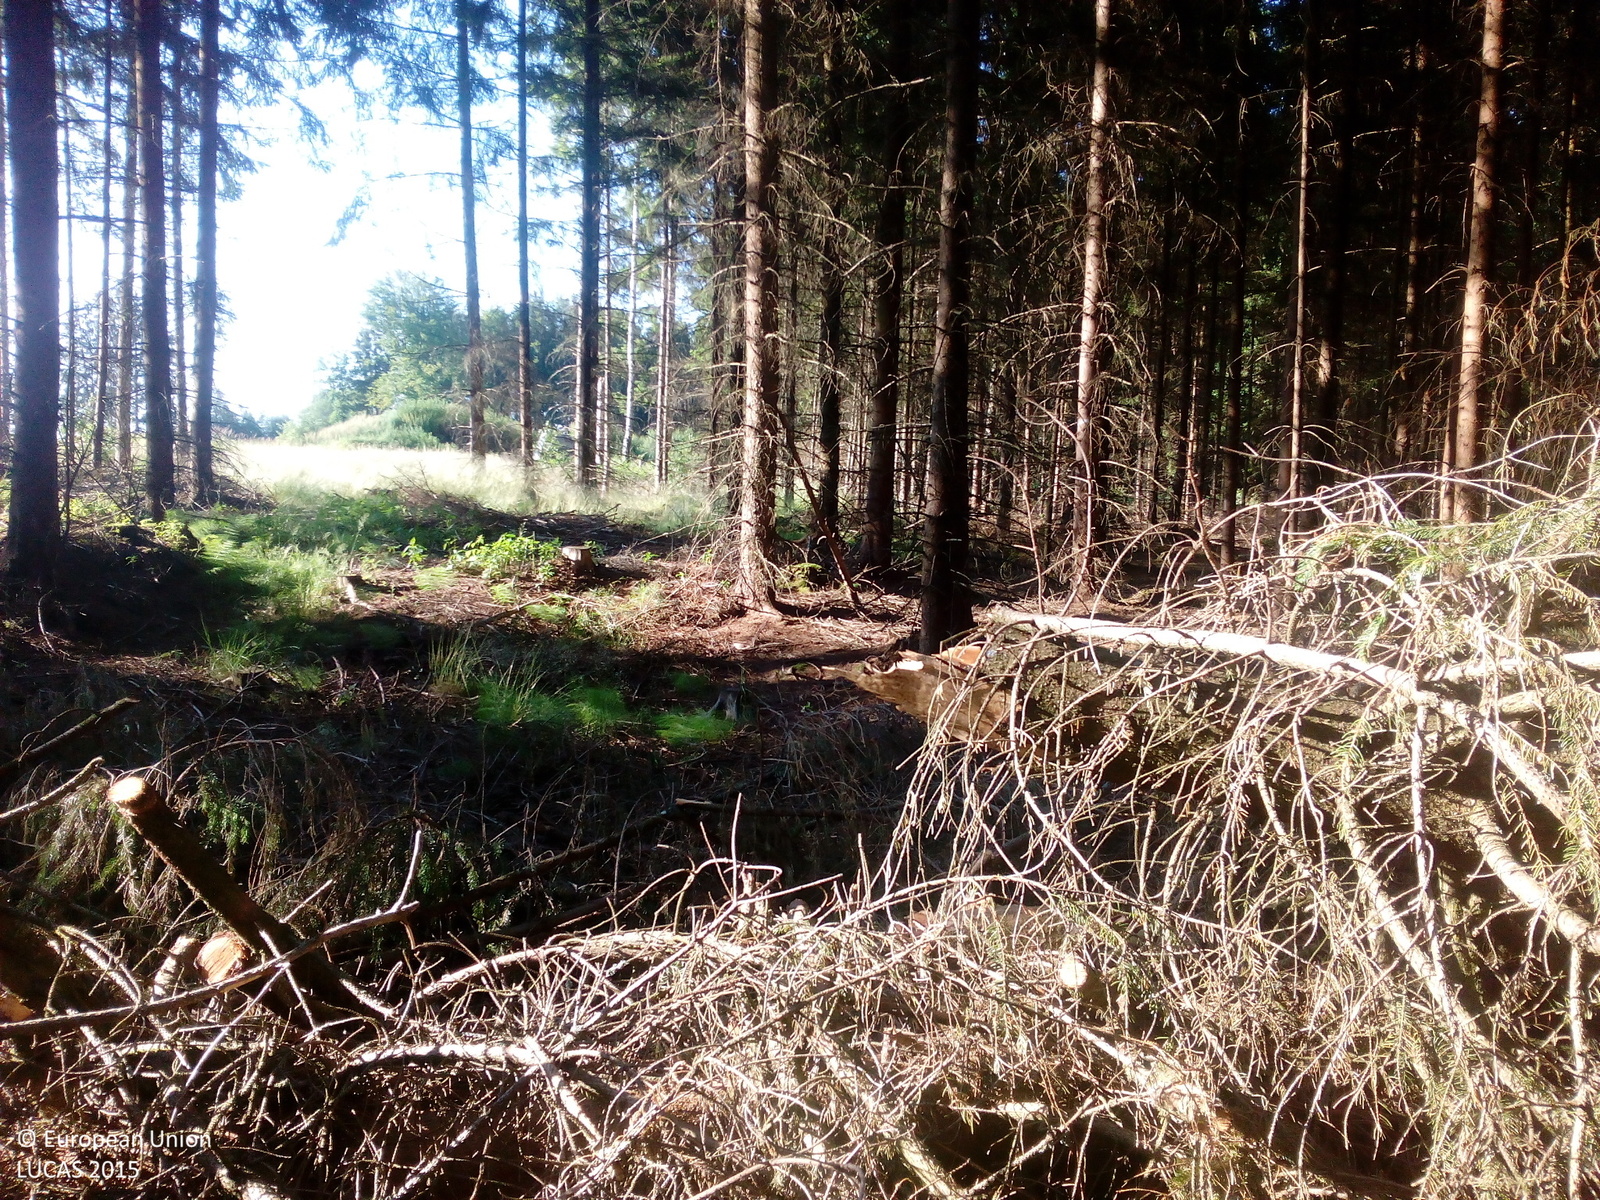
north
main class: Woodland
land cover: Spruce dominated coniferous woodland
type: hemiboreal forest and nemoral coniferous forest and mixed broadleaved-coniferous forest
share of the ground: > 75 %
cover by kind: coniferous forest trees 80 %, lichens and mosses 10 %, unconsolidated bare surface 10 %
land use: Forestry
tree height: > 5 m
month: July
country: DE
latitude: 49.6200
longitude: 12.3665
